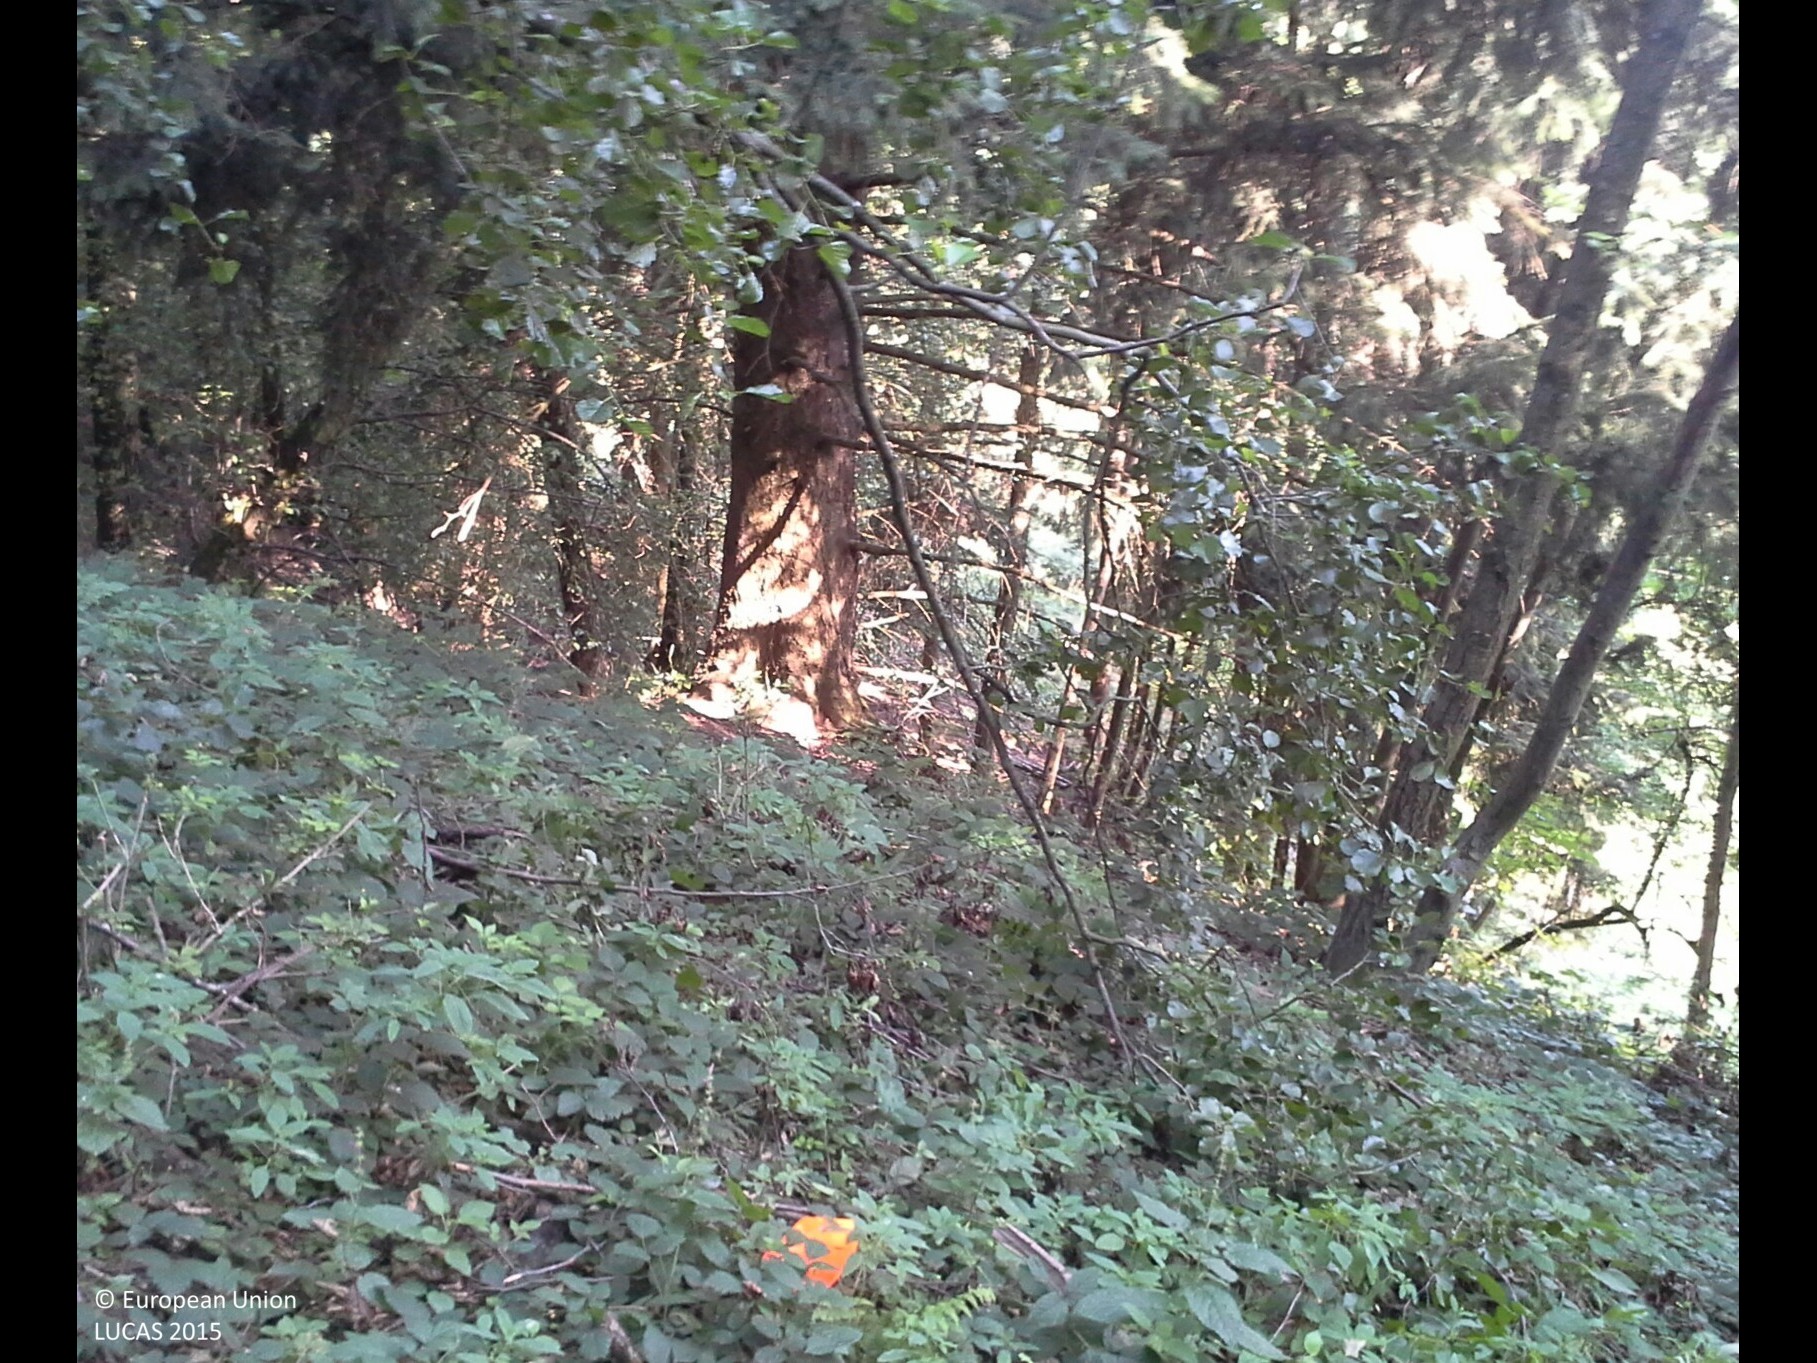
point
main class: Woodland
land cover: Other mixed woodland
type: mesophytic deciduous forest
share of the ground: > 75 %
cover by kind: broadleaved forest trees 60 %, coniferous forest trees 30 %, herbaceous plants 10 %
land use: Forestry
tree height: > 5 m
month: July
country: AT
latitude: 48.0403
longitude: 14.9502
